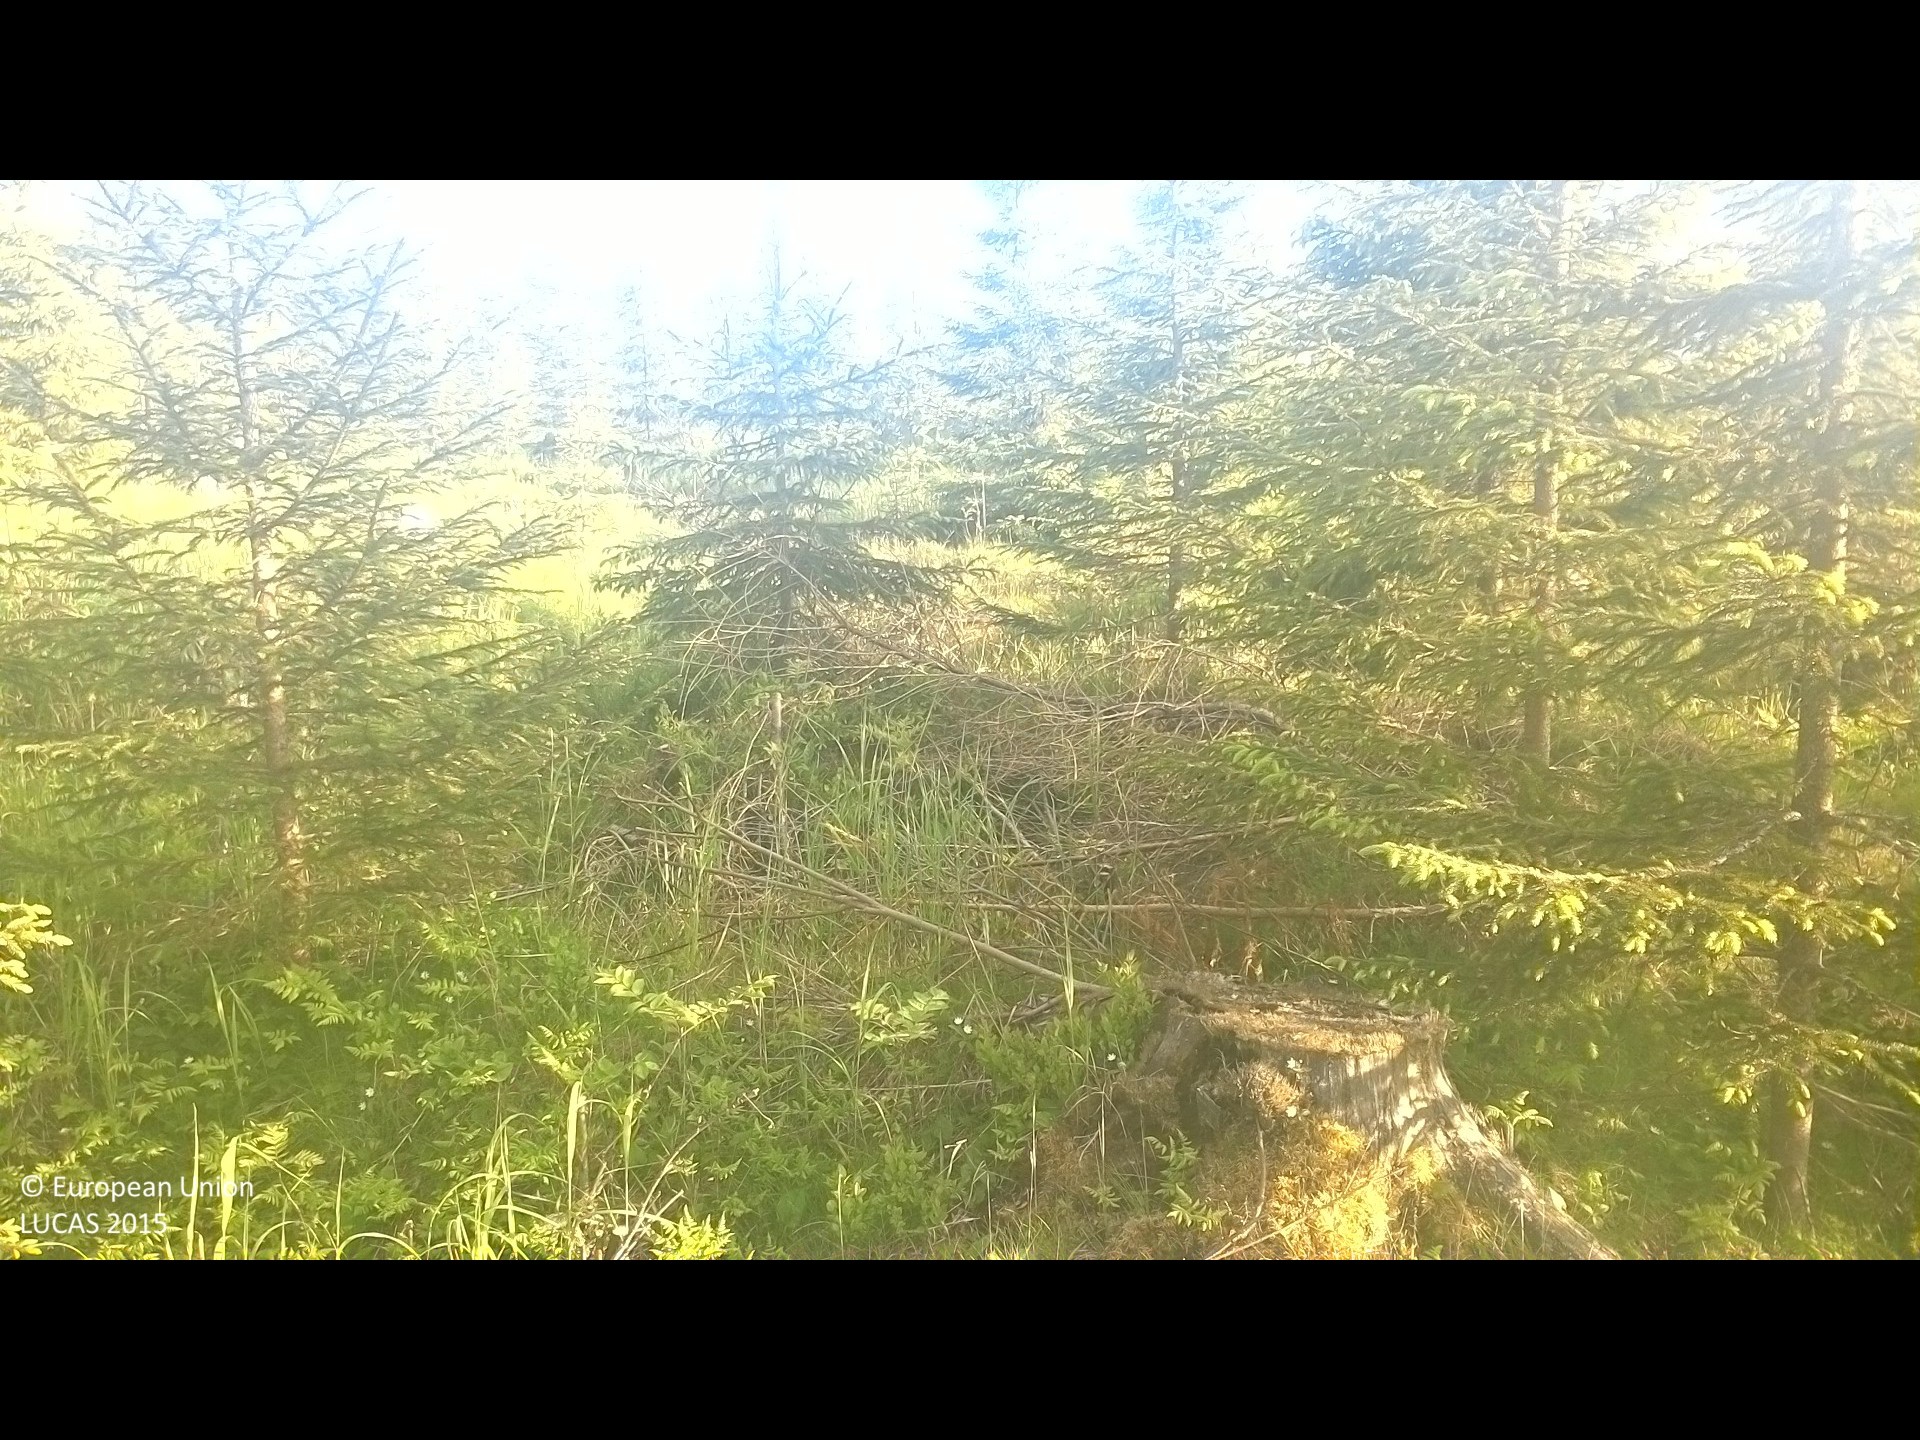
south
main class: Woodland
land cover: Spruce dominated coniferous woodland
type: boreal forest
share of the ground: 25 - 50 %
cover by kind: herbaceous plants 50 %, coniferous forest trees 25 %, lichens and mosses 20 %, broadleaved forest trees 5 %
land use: Forestry
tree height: < 5 m
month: June
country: SE
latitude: 62.0276
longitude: 16.7279
